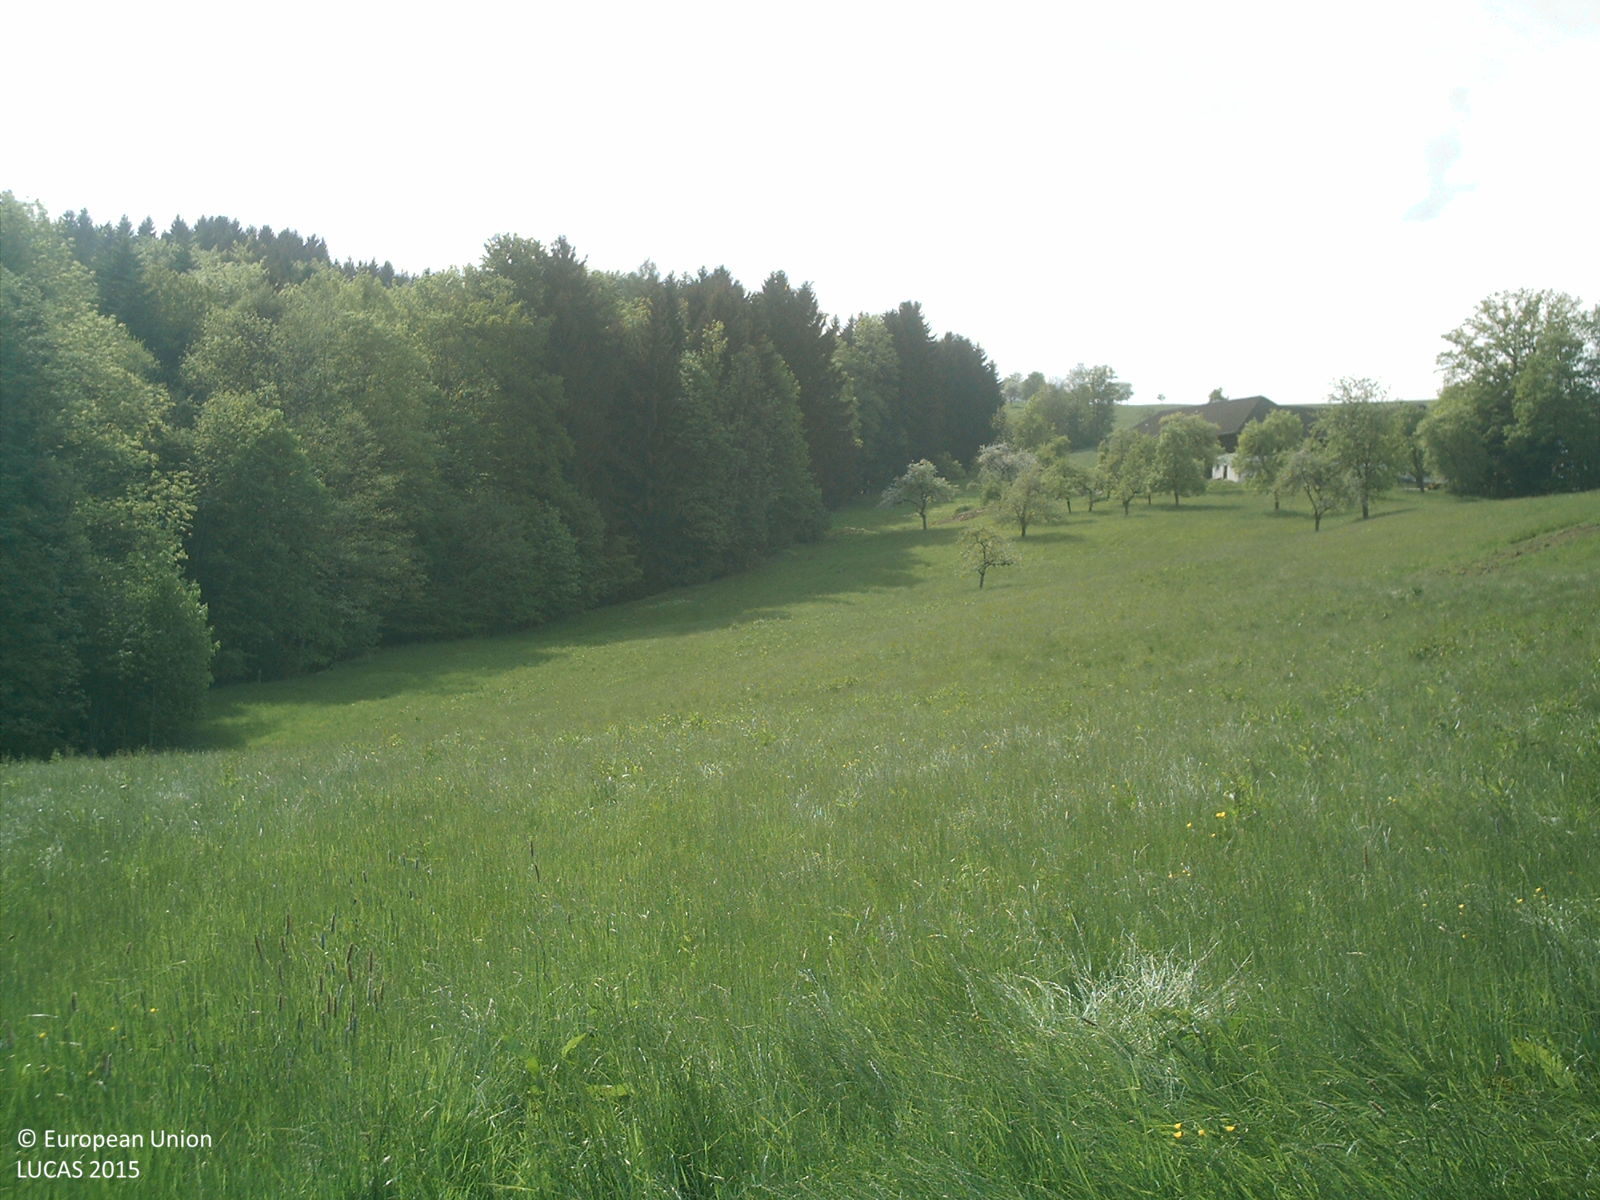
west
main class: Grassland
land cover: Grassland without tree/shrub cover
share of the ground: > 75 %
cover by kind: herbaceous plants 100 %
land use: Agriculture (excluding fallow land and kitchen gardens)
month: May
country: AT
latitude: 47.9498
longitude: 14.0833
